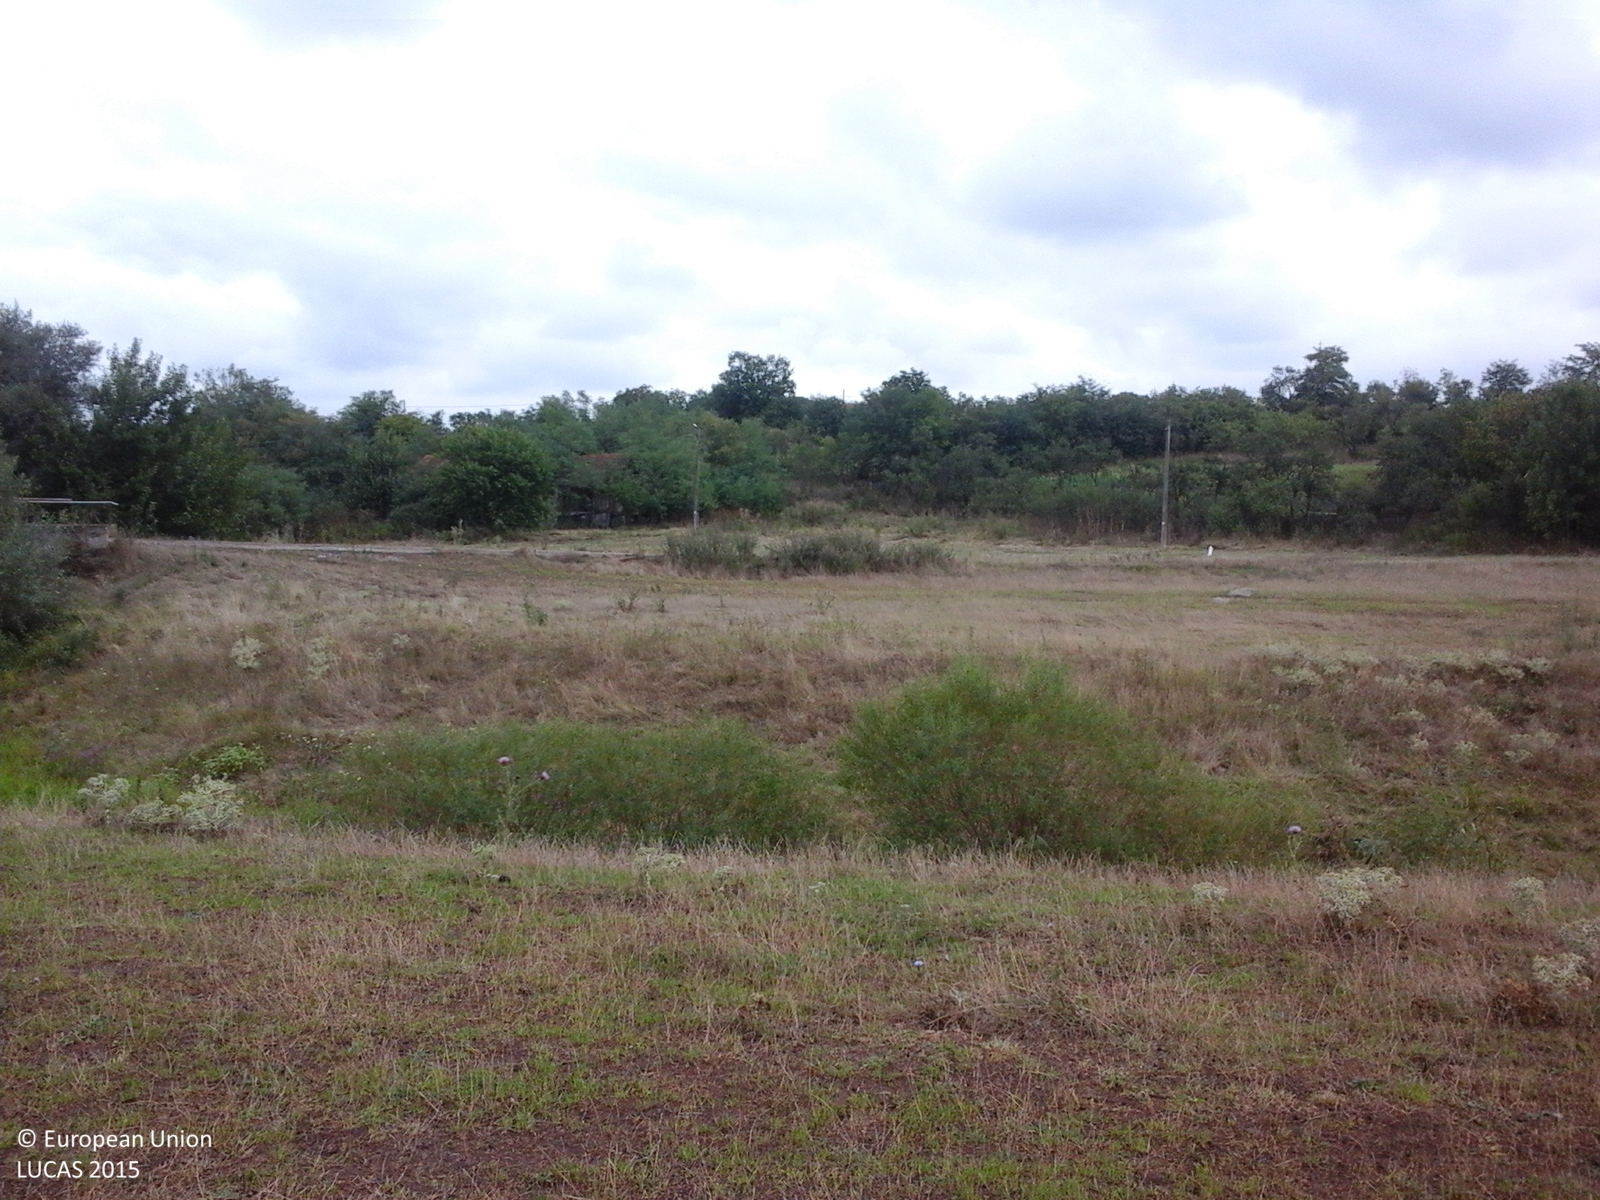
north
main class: Grassland
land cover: Grassland without tree/shrub cover
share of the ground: > 75 %
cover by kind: herbaceous plants 100 %
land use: Agriculture (excluding fallow land and kitchen gardens)
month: August
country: RO
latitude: 45.8063
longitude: 21.7857
